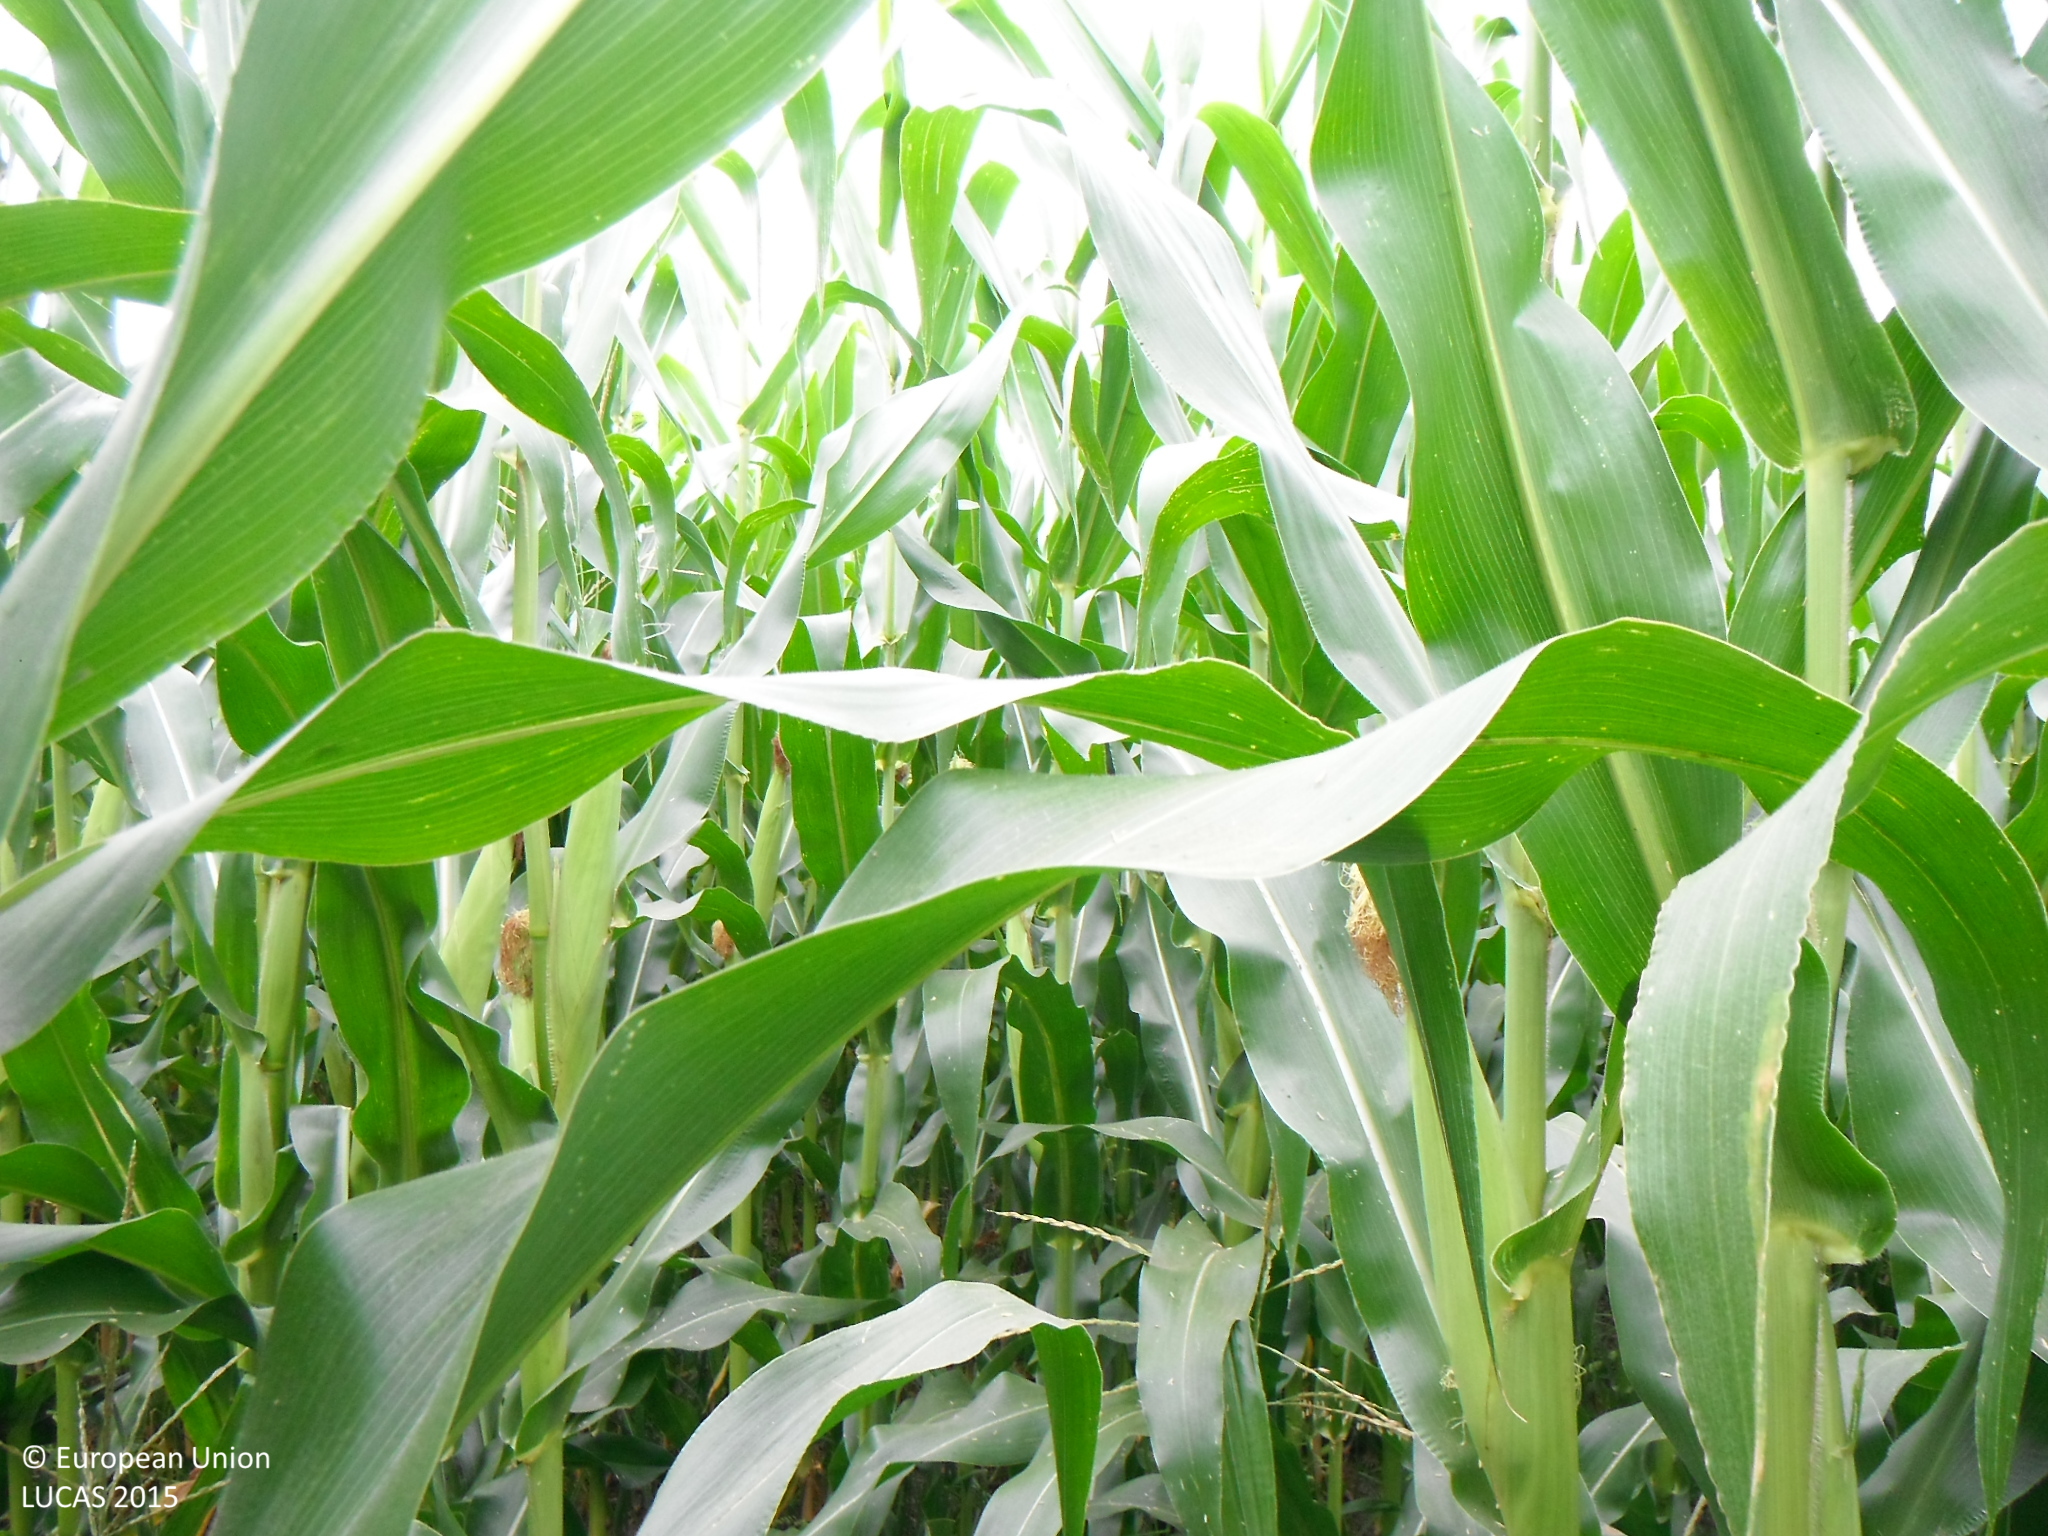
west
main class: Cropland
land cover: Maize
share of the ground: > 75 %
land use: Agriculture (excluding fallow land and kitchen gardens)
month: July
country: SK
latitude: 48.1698
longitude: 19.9653
